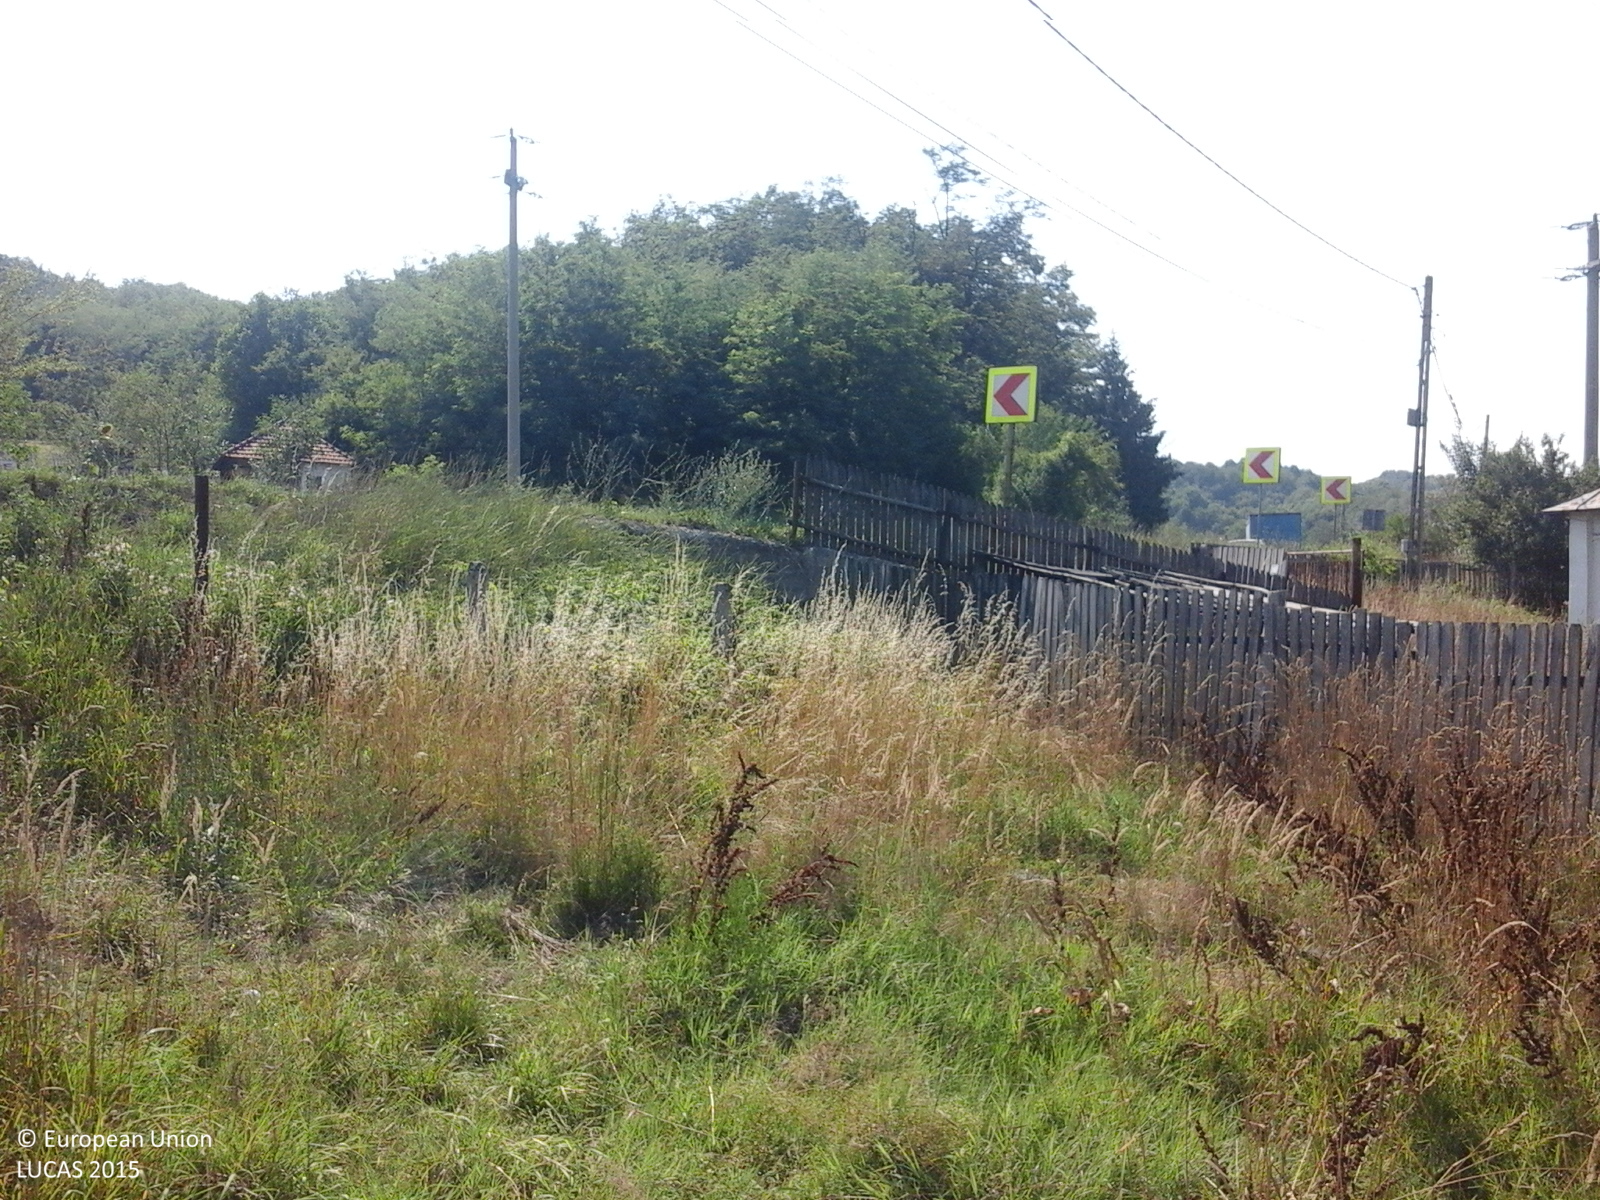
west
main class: Grassland
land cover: Spontaneously vegetated surfaces
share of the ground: > 75 %
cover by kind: herbaceous plants 100 %
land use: Agriculture (excluding fallow land and kitchen gardens)
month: July
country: RO
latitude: 45.0301
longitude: 24.4813
